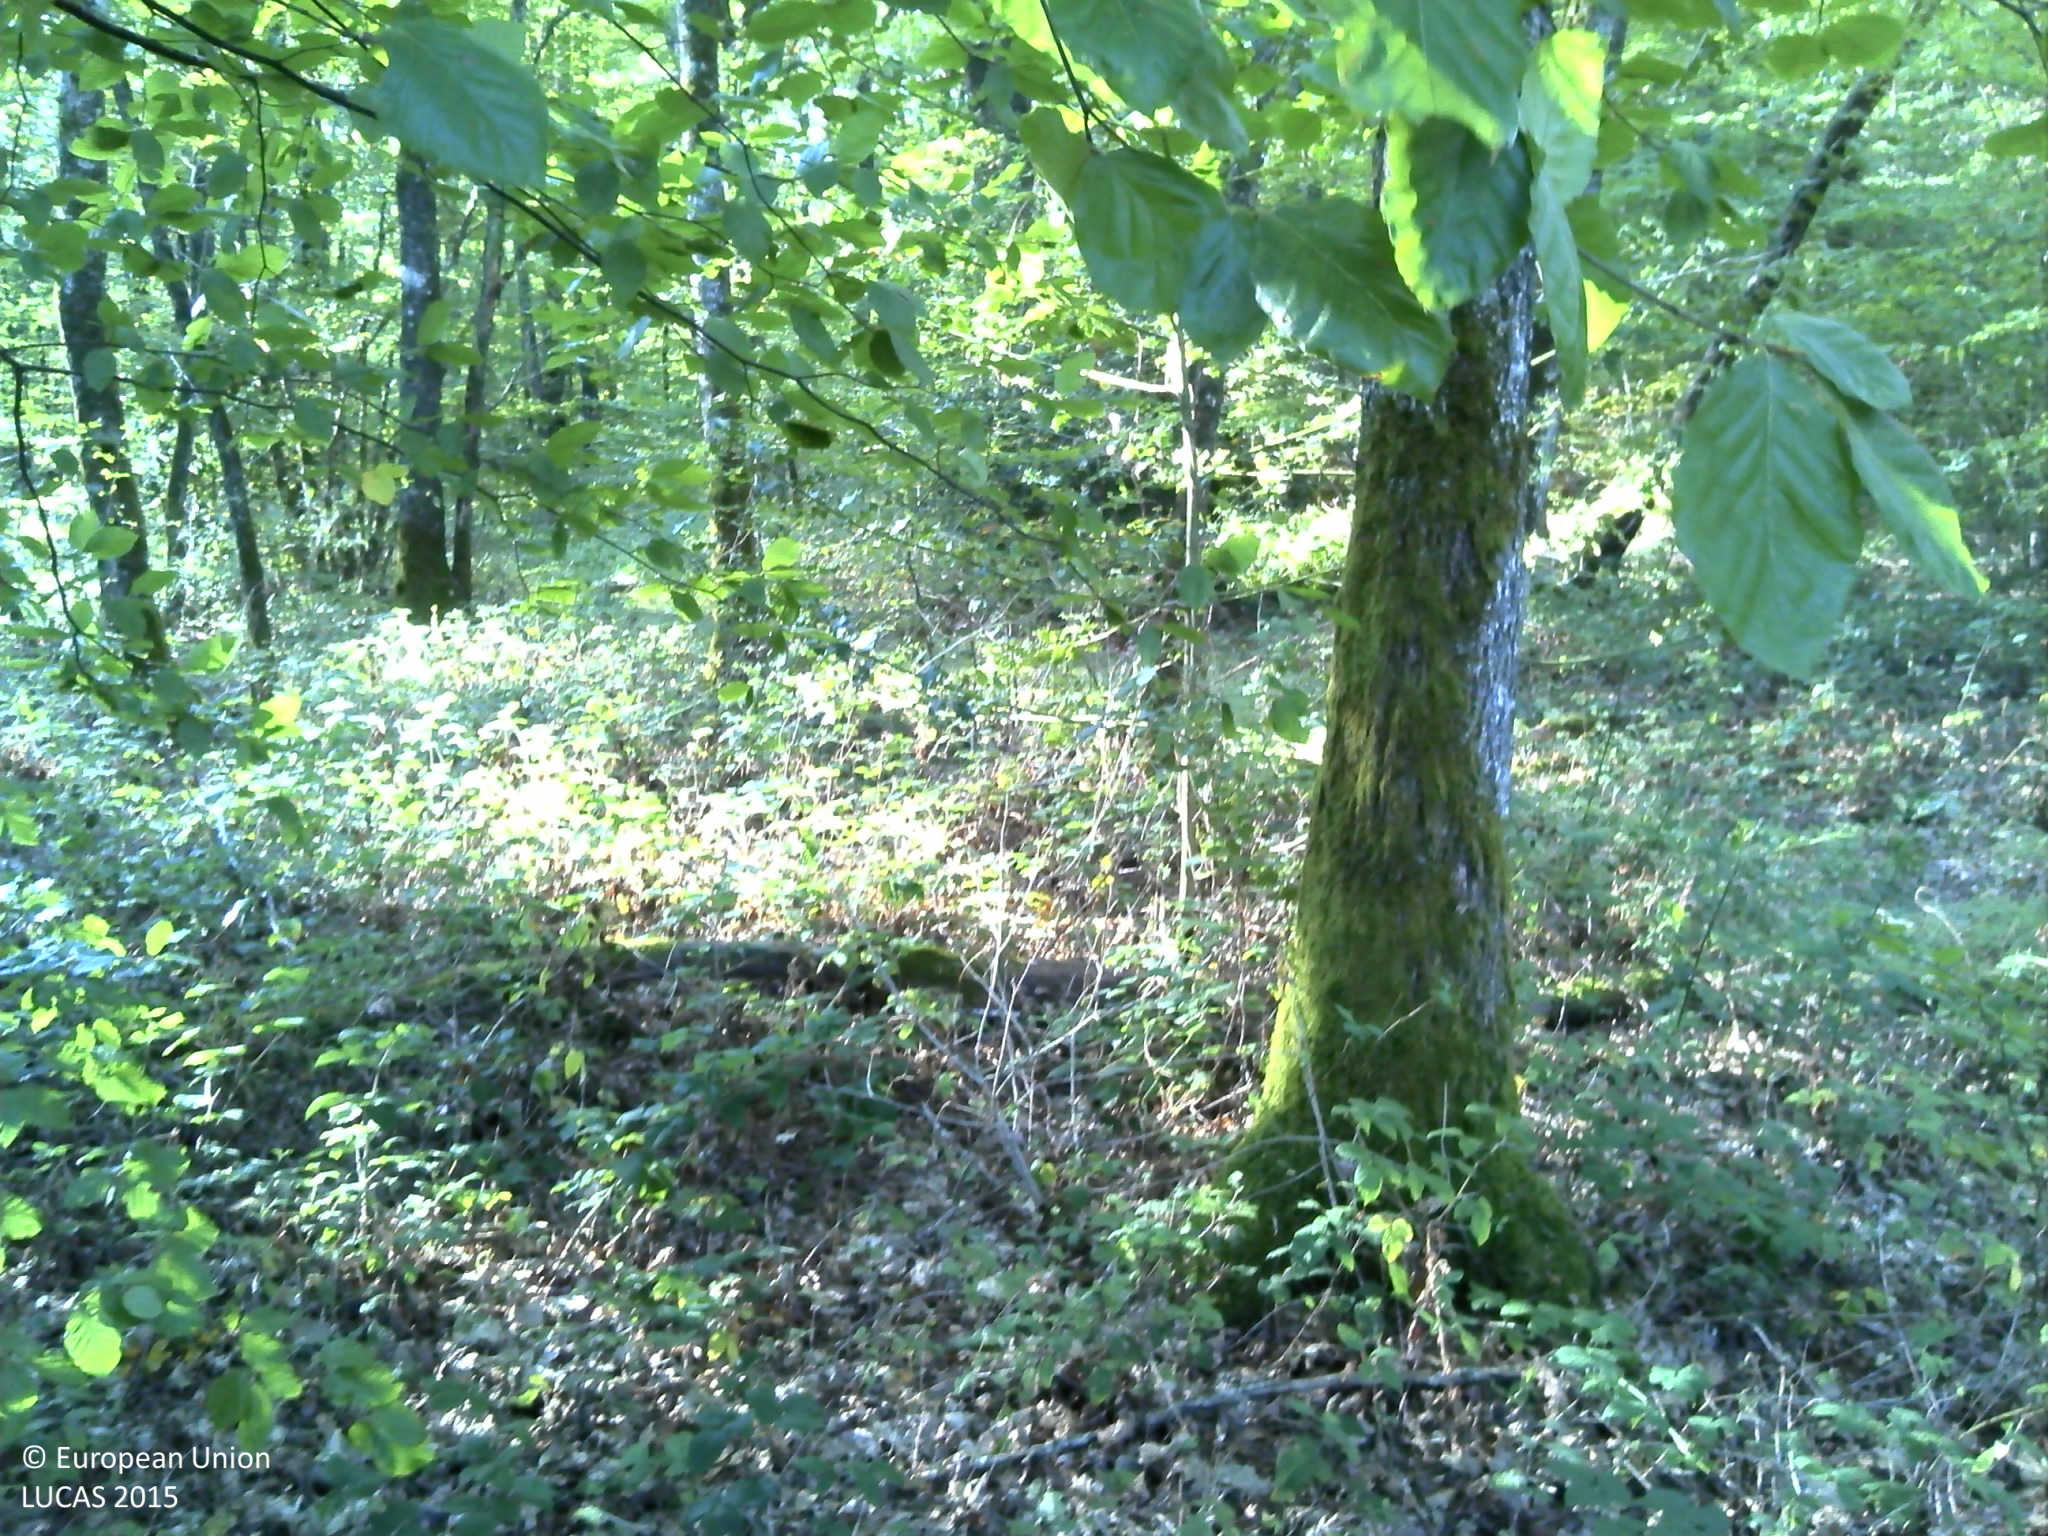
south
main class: Woodland
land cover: Broadleaved woodland
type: mesophytic deciduous forest
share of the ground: > 75 %
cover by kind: broadleaved forest trees 85 %, herbaceous plants 5 %, lichens and mosses 5 %
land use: Forestry
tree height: > 5 m
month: September
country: FR
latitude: 46.9109
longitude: 4.4465
